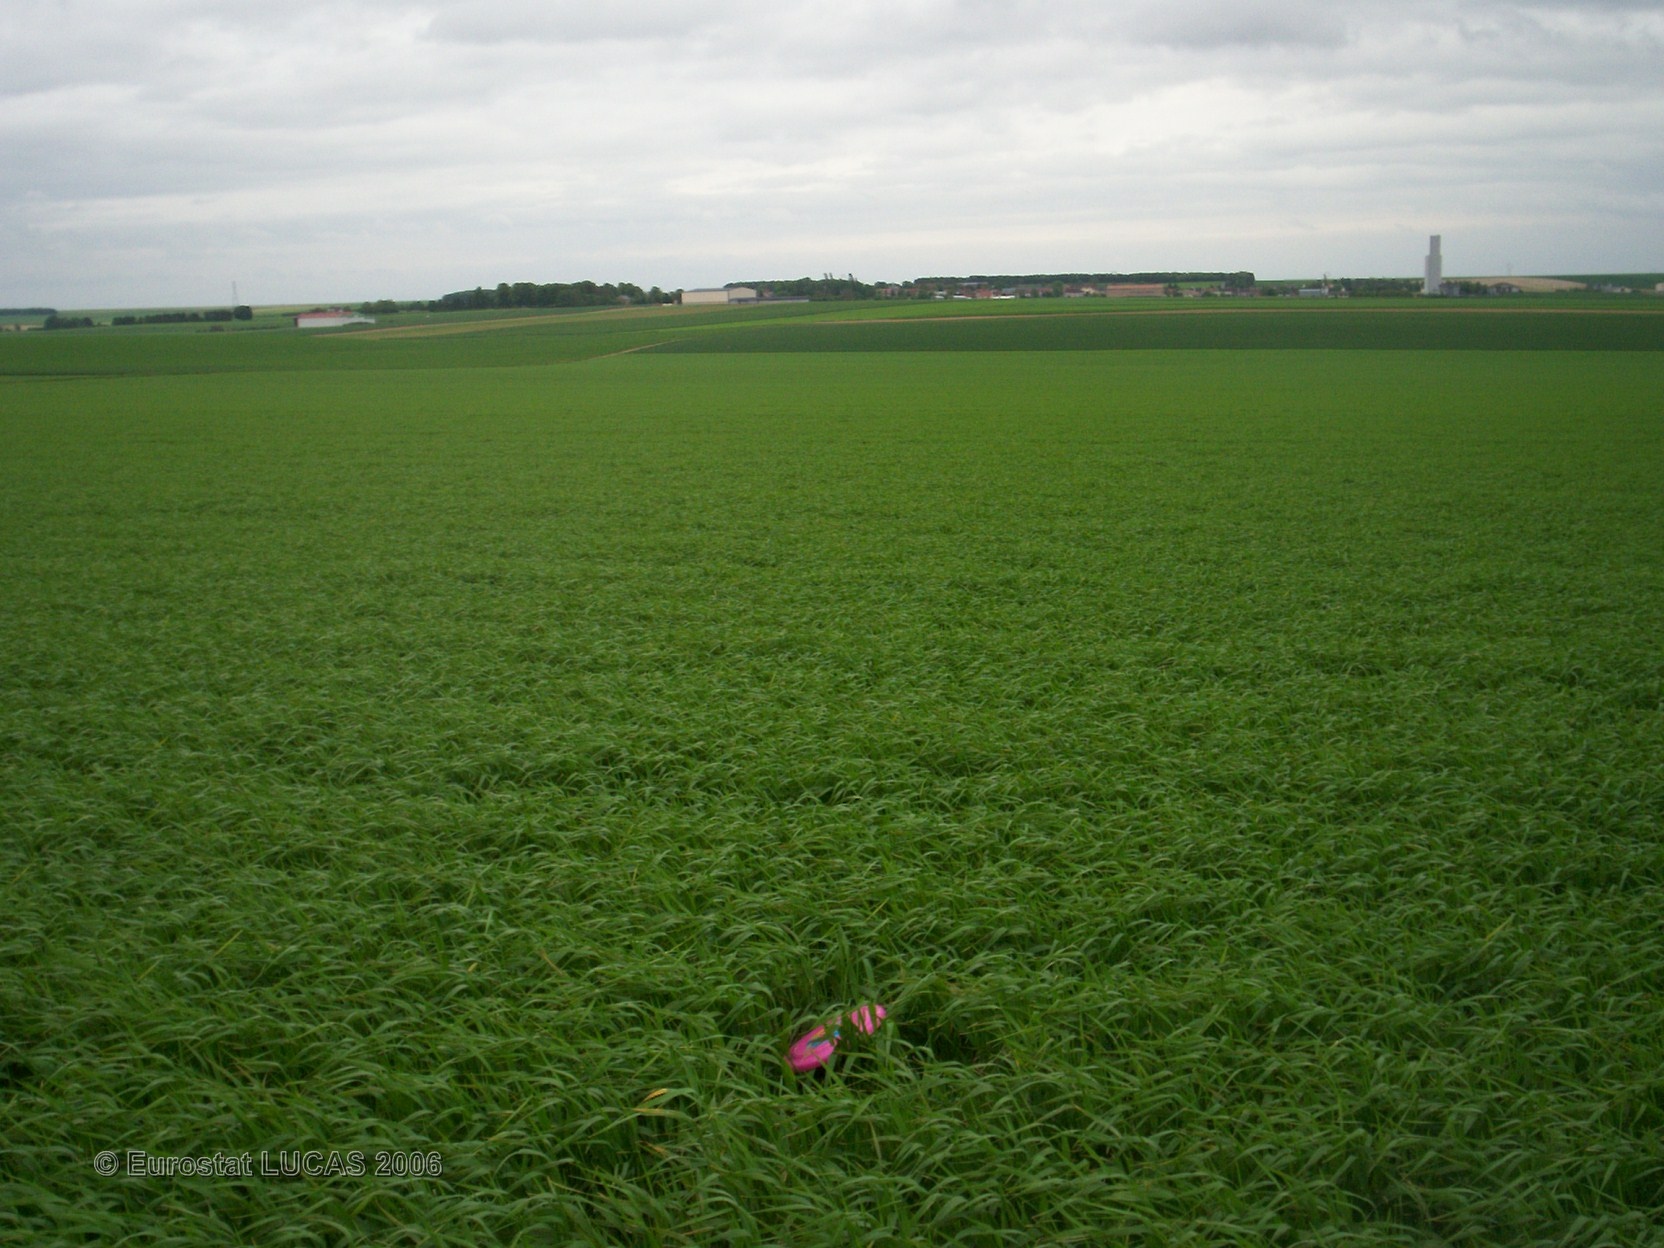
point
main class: Cropland
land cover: Barley
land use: Agriculture (excluding fallow land and kitchen gardens)
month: May
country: FR
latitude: 49.3598
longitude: 4.3646
